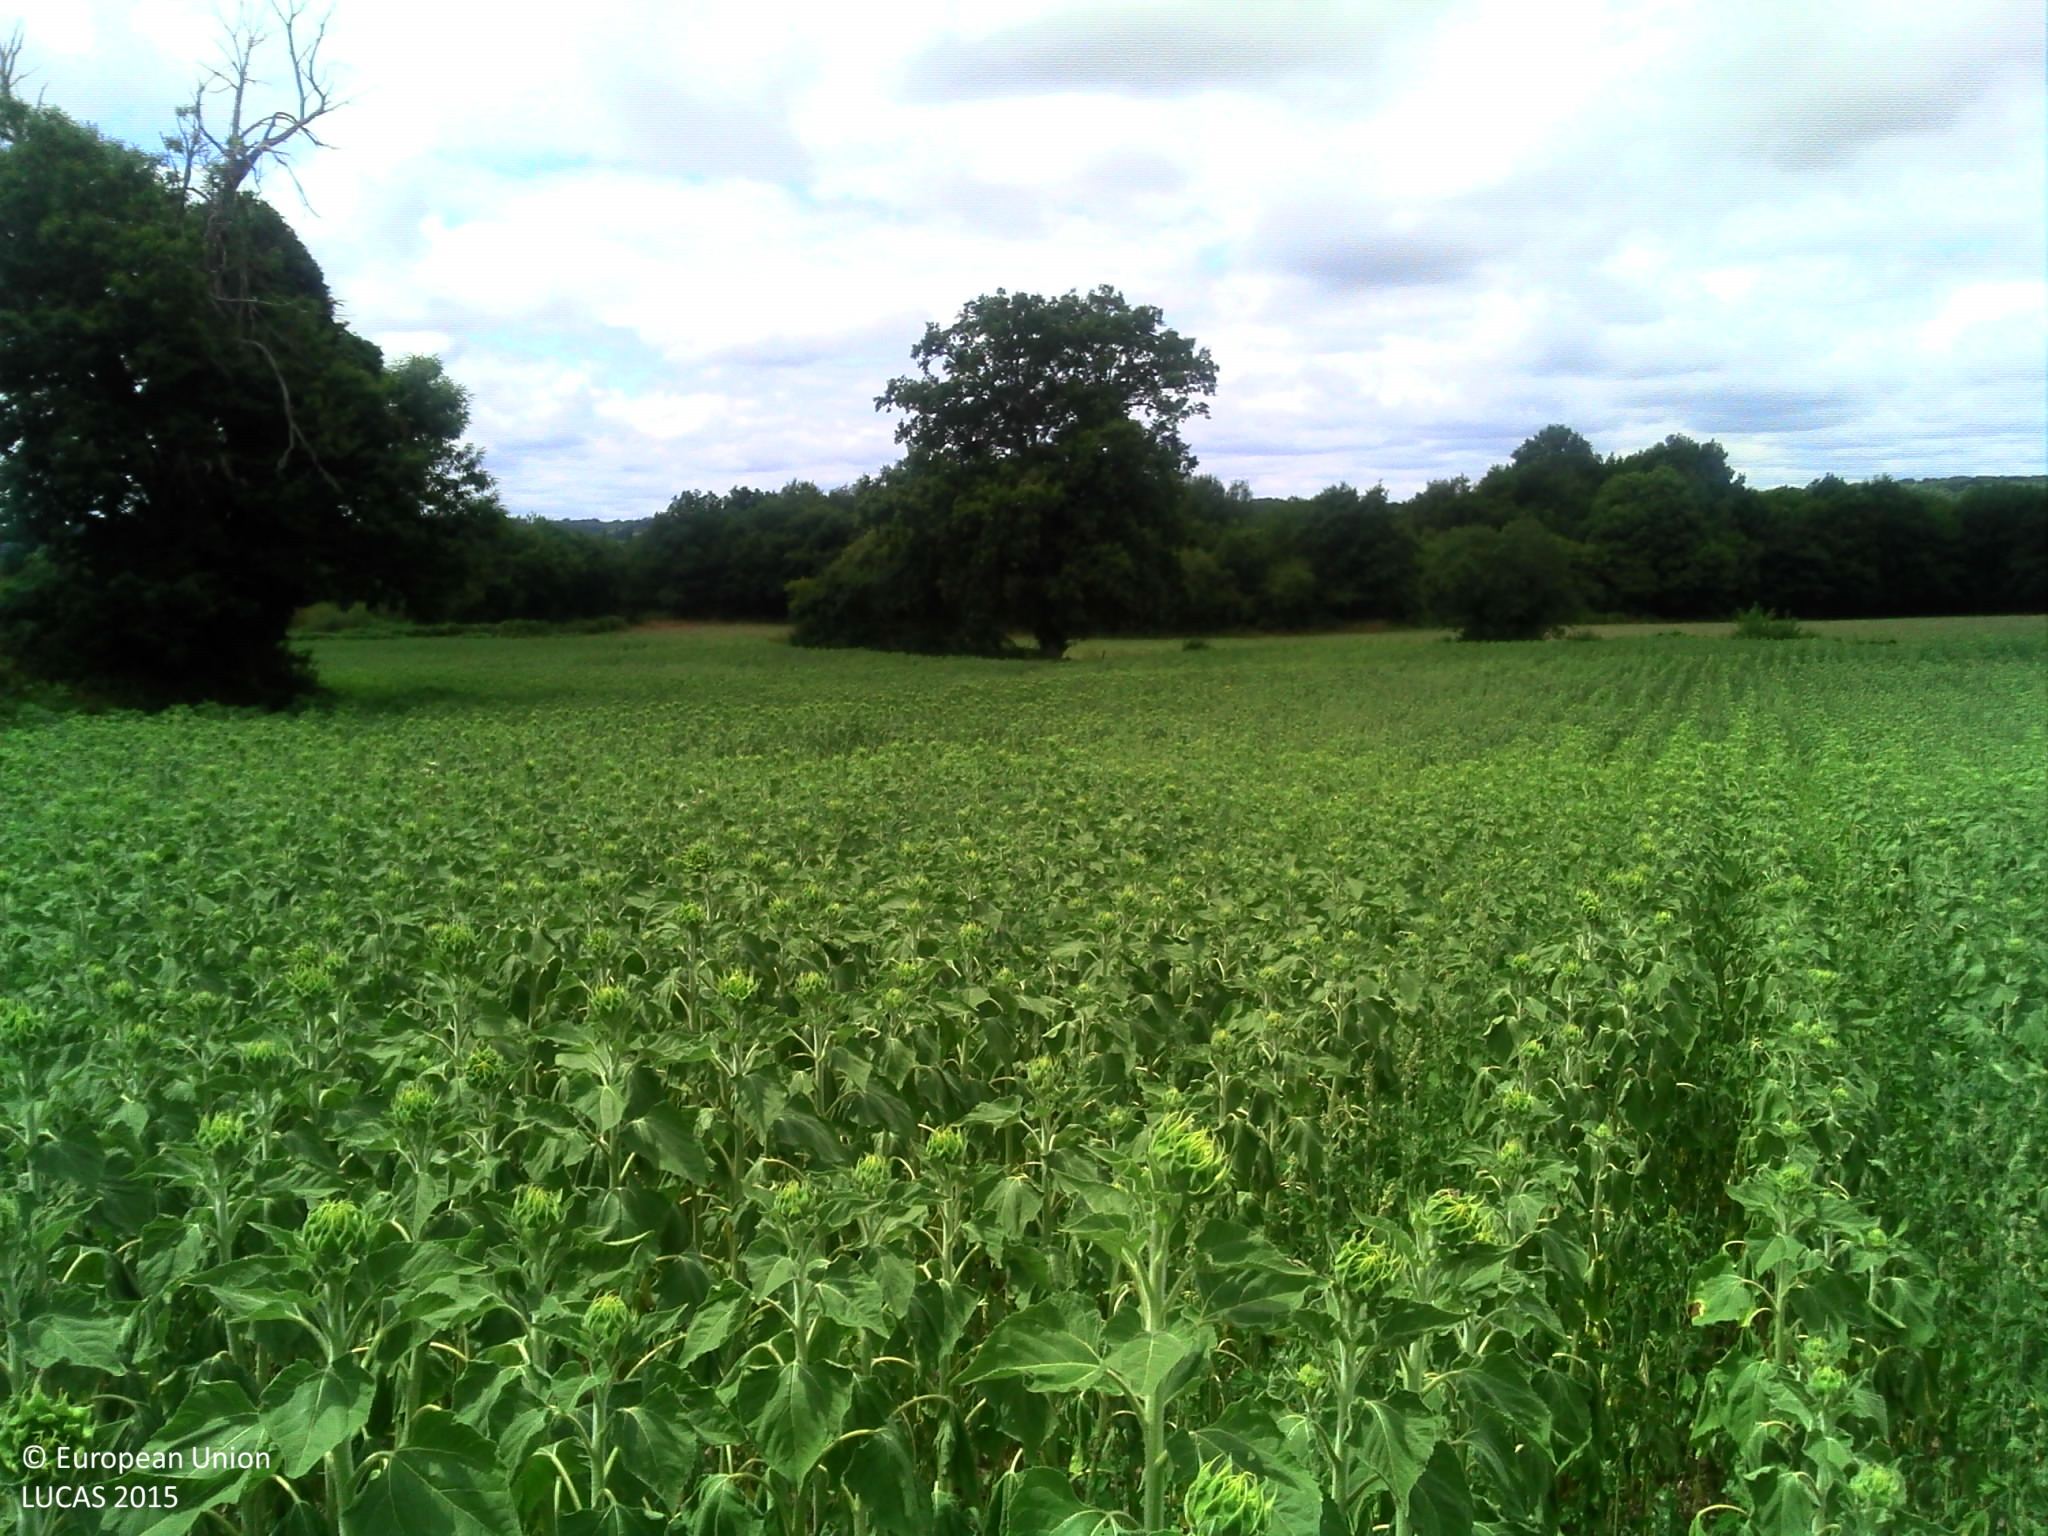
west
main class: Cropland
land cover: Sunflower
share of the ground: > 75 %
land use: Agriculture (excluding fallow land and kitchen gardens)
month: July
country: FR
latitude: 46.3649
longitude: 1.6071
